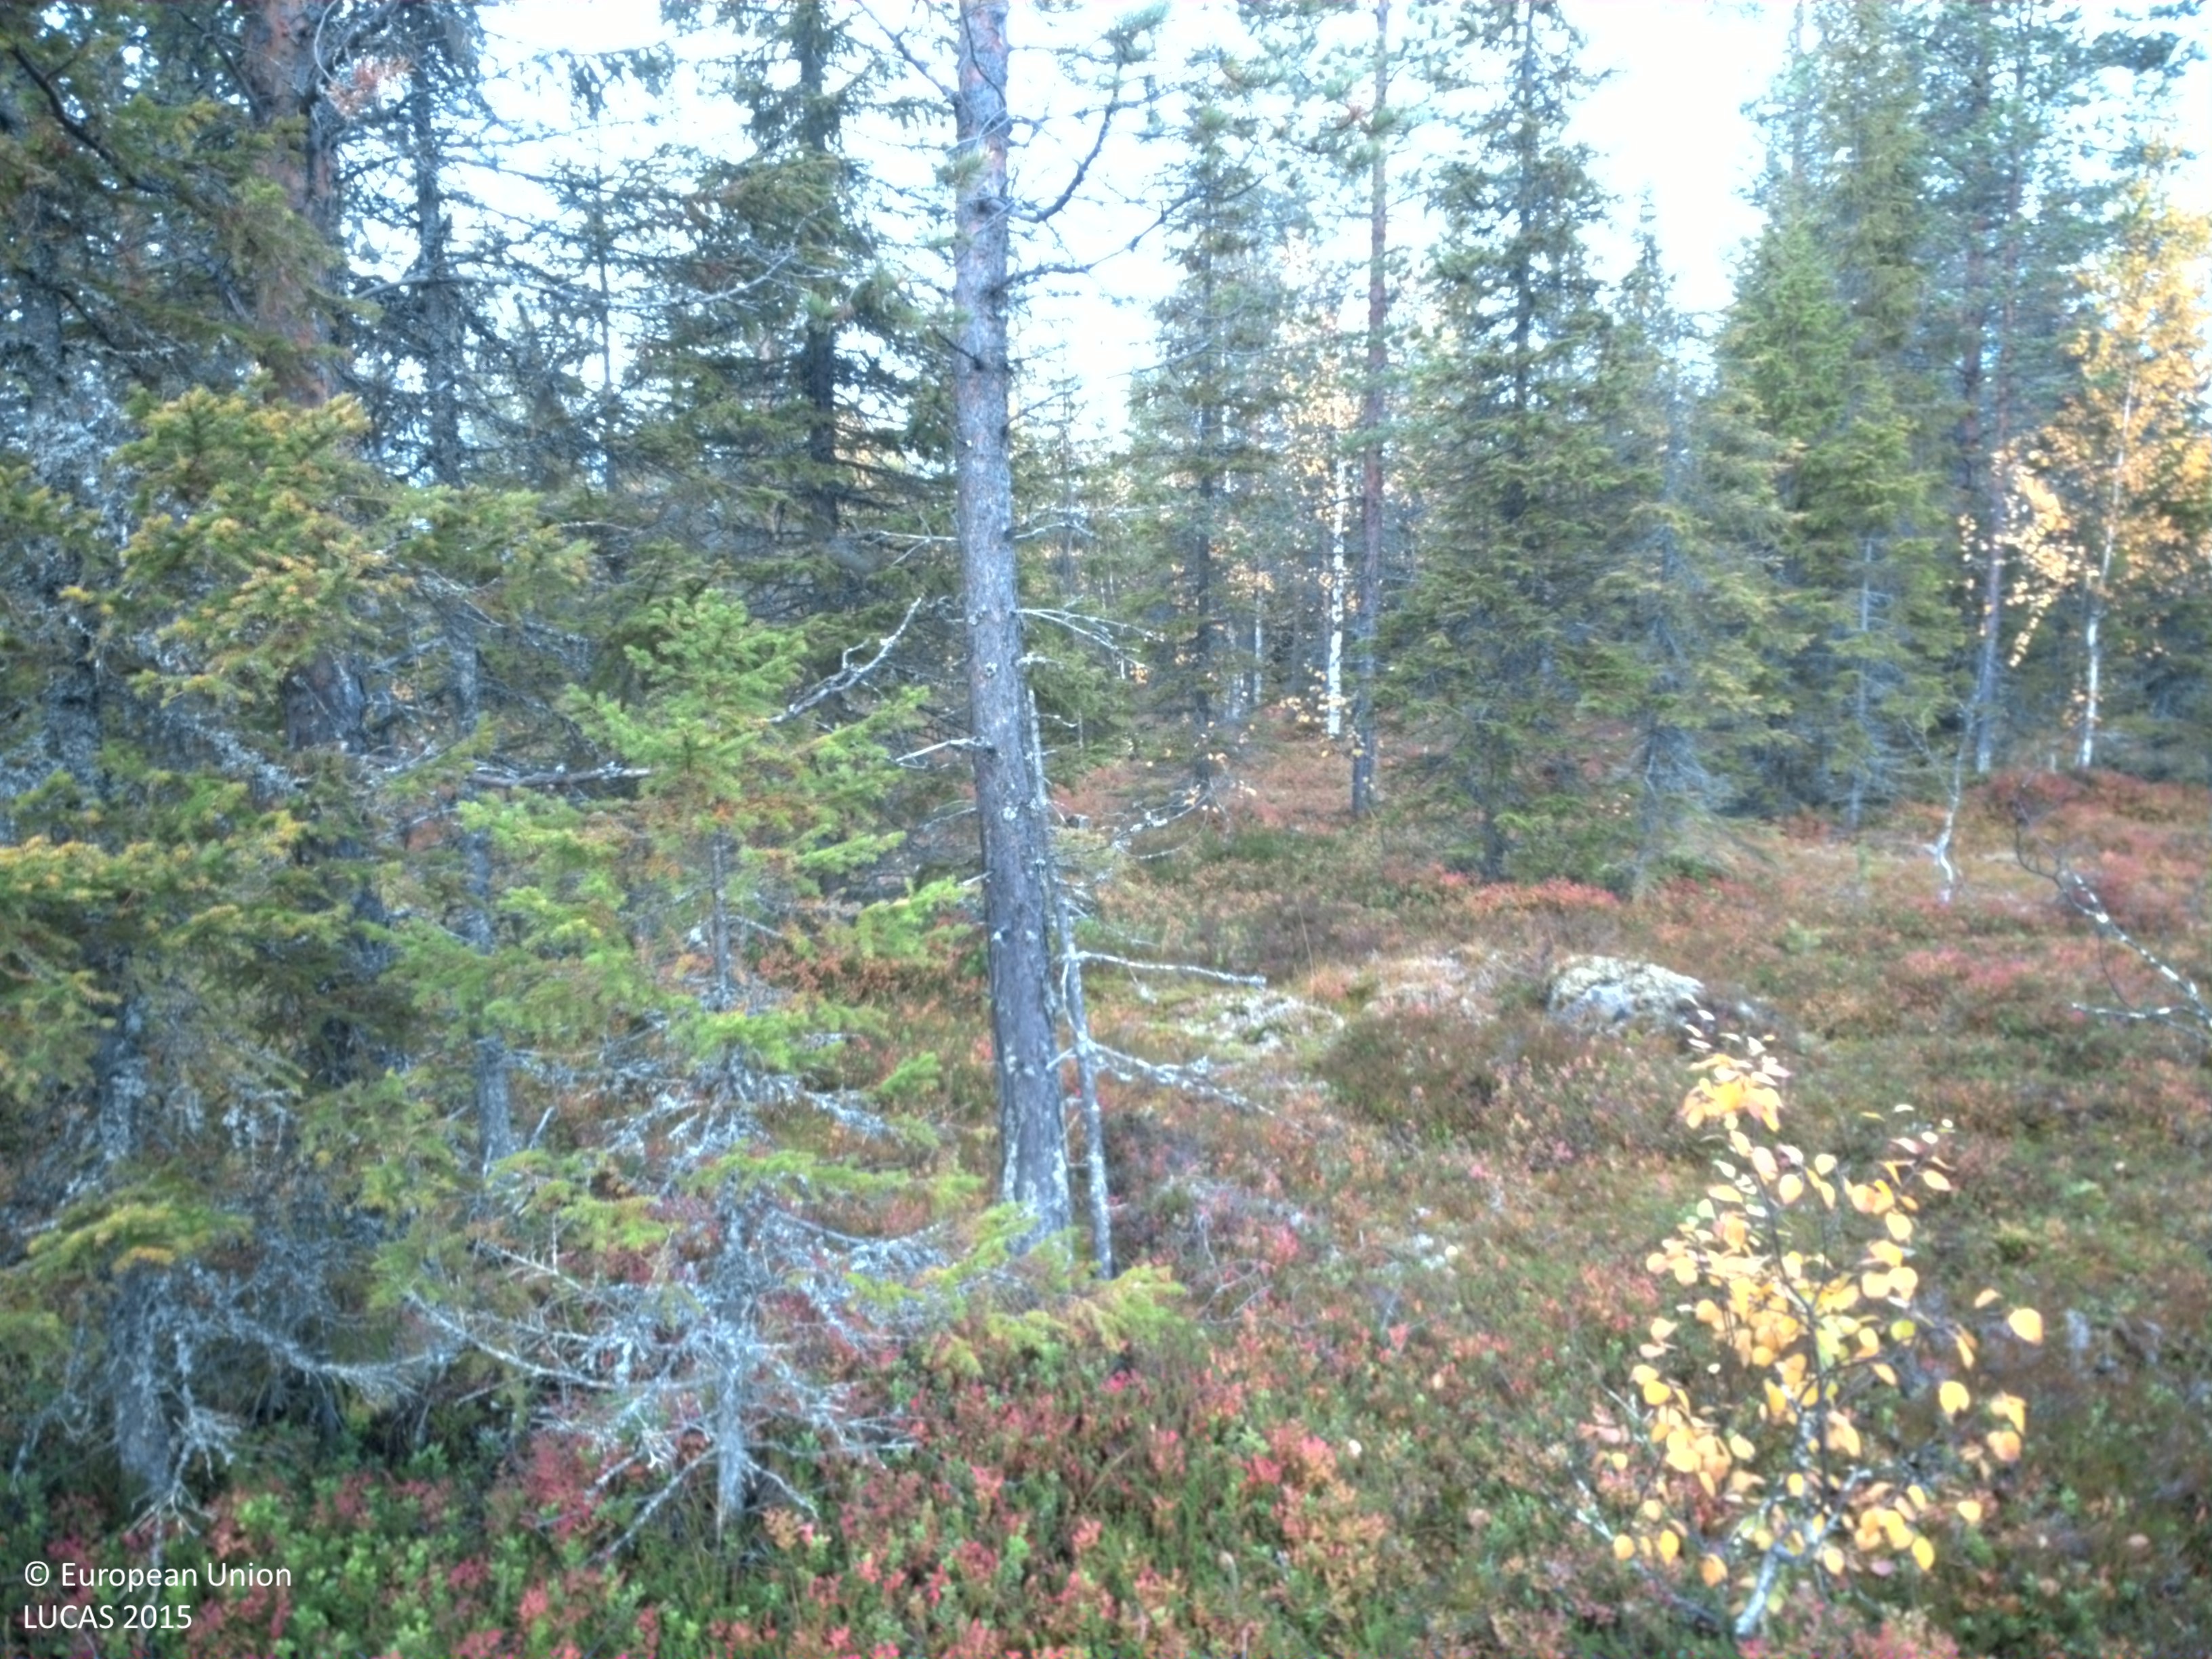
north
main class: Woodland
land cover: Other mixed woodland
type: boreal forest
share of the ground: 10 - 25 %
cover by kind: shrubs 55 %, lichens and mosses 20 %, coniferous forest trees 15 %, broadleaved forest trees 5 %, herbaceous plants 5 %
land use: Forestry
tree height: > 5 m
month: September
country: SE
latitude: 65.0357
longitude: 17.9265
